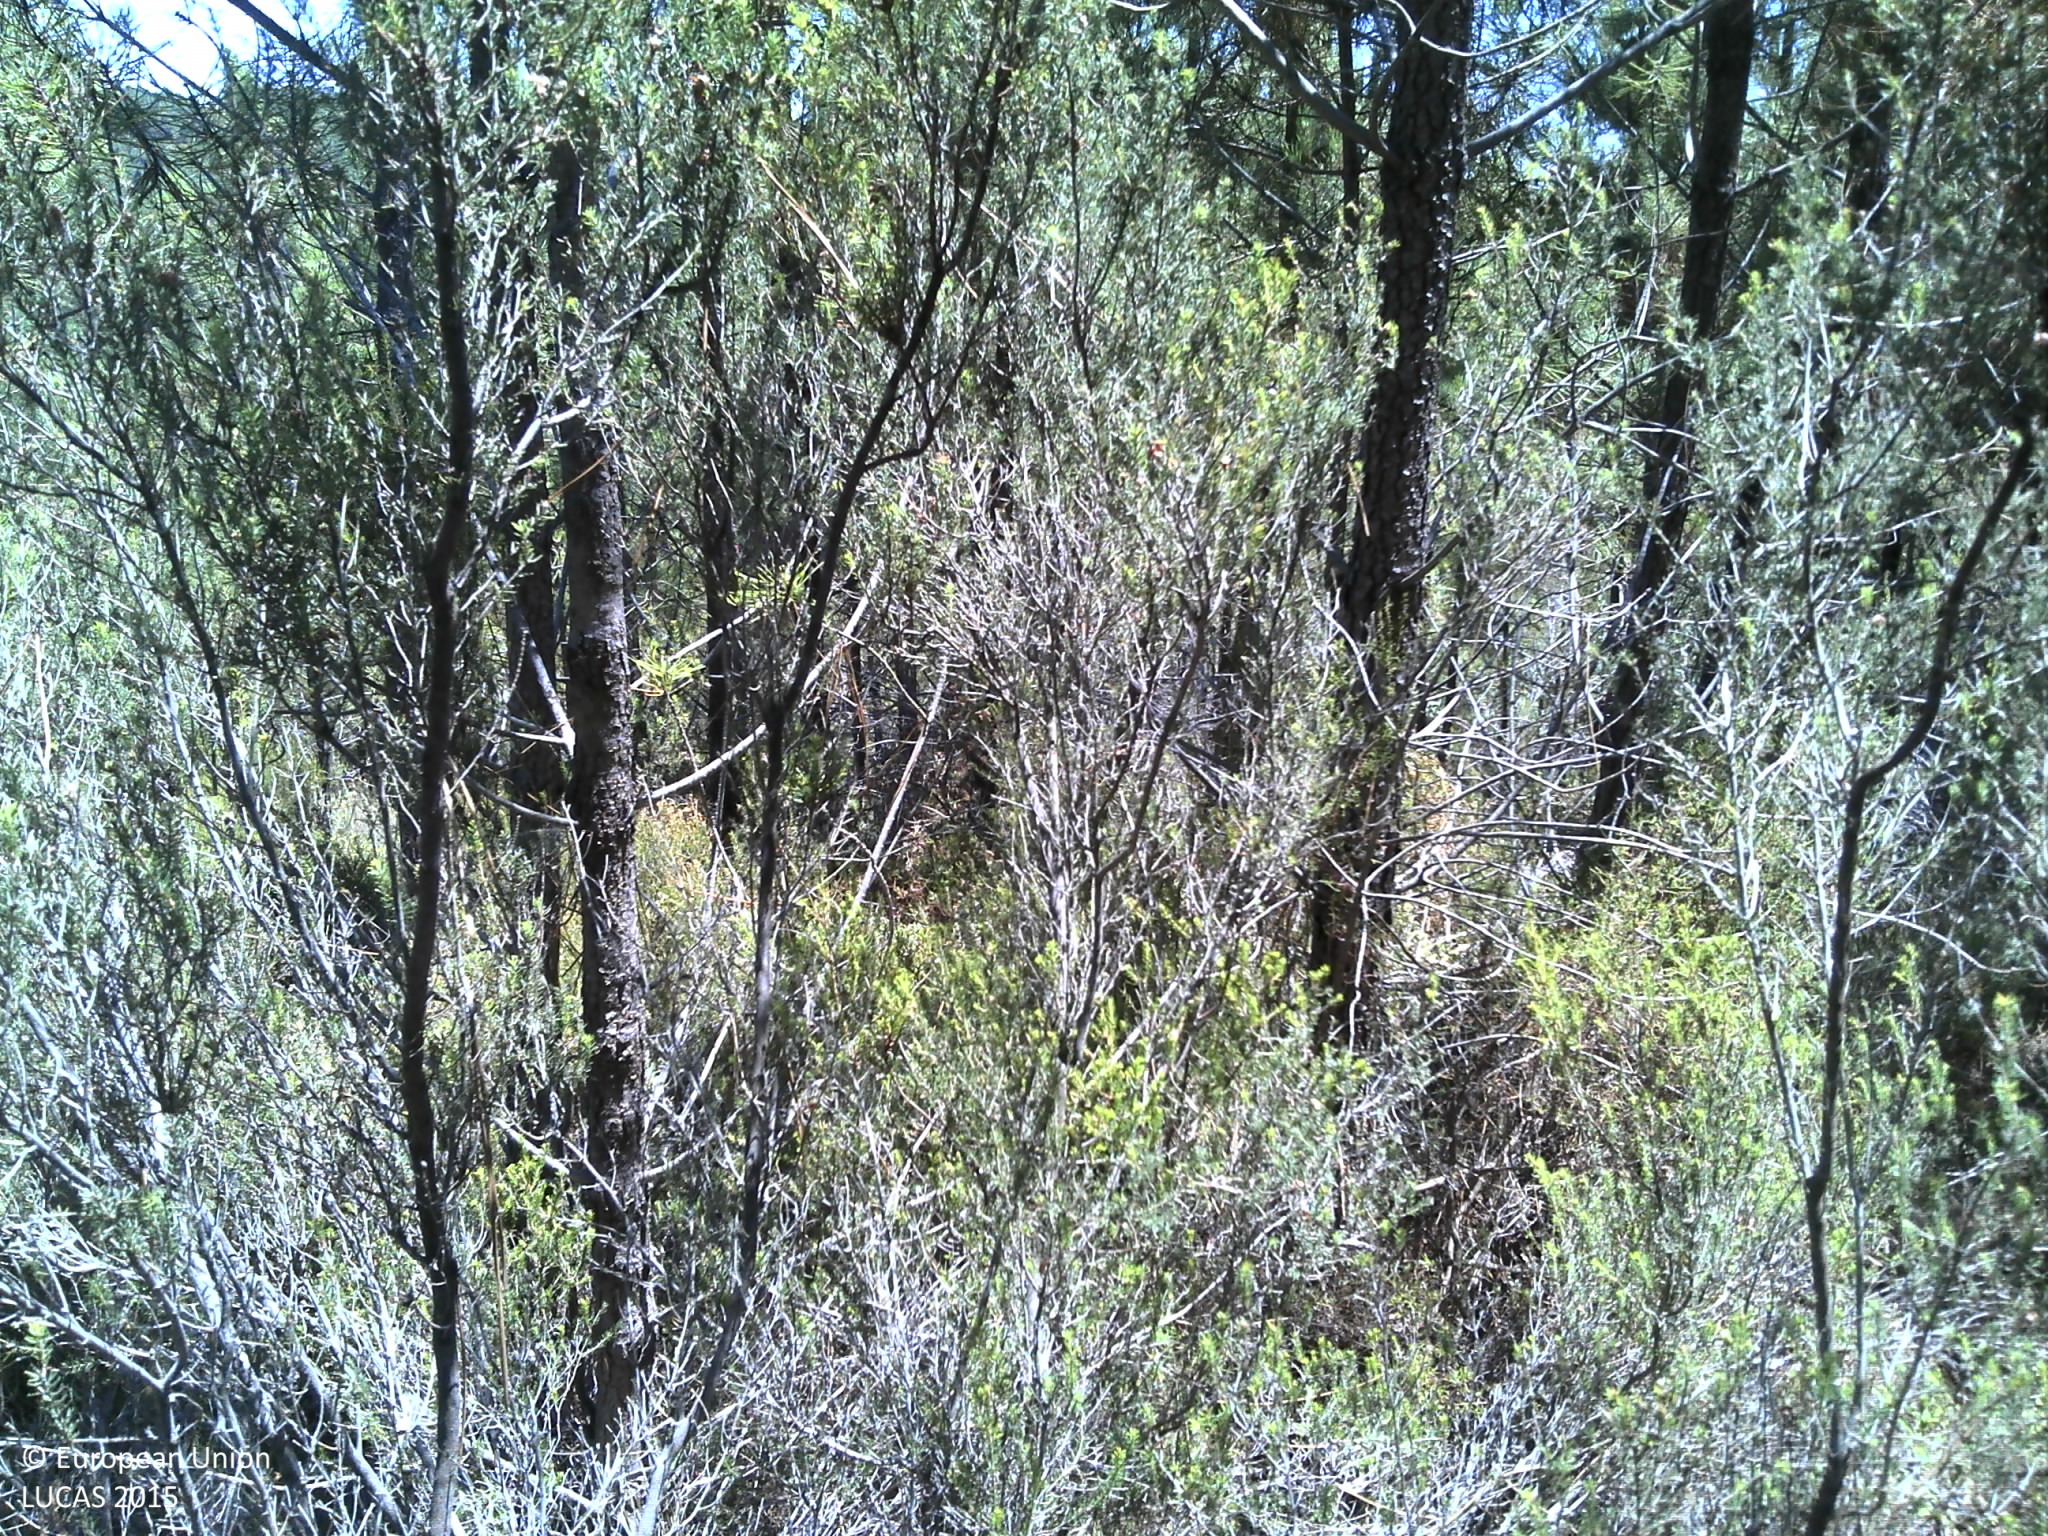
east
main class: Woodland
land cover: Pine dominated coniferous woodland
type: coniferous forest of the mediterranean region
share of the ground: 10 - 25 %
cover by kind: shrubs 85 %, coniferous forest trees 15 %
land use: Forestry
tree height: > 5 m
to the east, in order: Pine dominated coniferous woodland; Tracks; Pine dominated coniferous woodland; Tracks; Pine dominated coniferous woodland; Dry stone walls; Olive groves; Dry stone walls; Single bushes/trees; Ditches and canals; Dry stone walls; Olive groves; Fences; Dry stone walls; Tracks; Pine dominated coniferous woodland; Dry stone walls; Olive groves; Dry stone walls; Ditches and canals; Dry stone walls; Broadleaved woodland
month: July
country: PT
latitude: 39.7551
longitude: -7.9794
